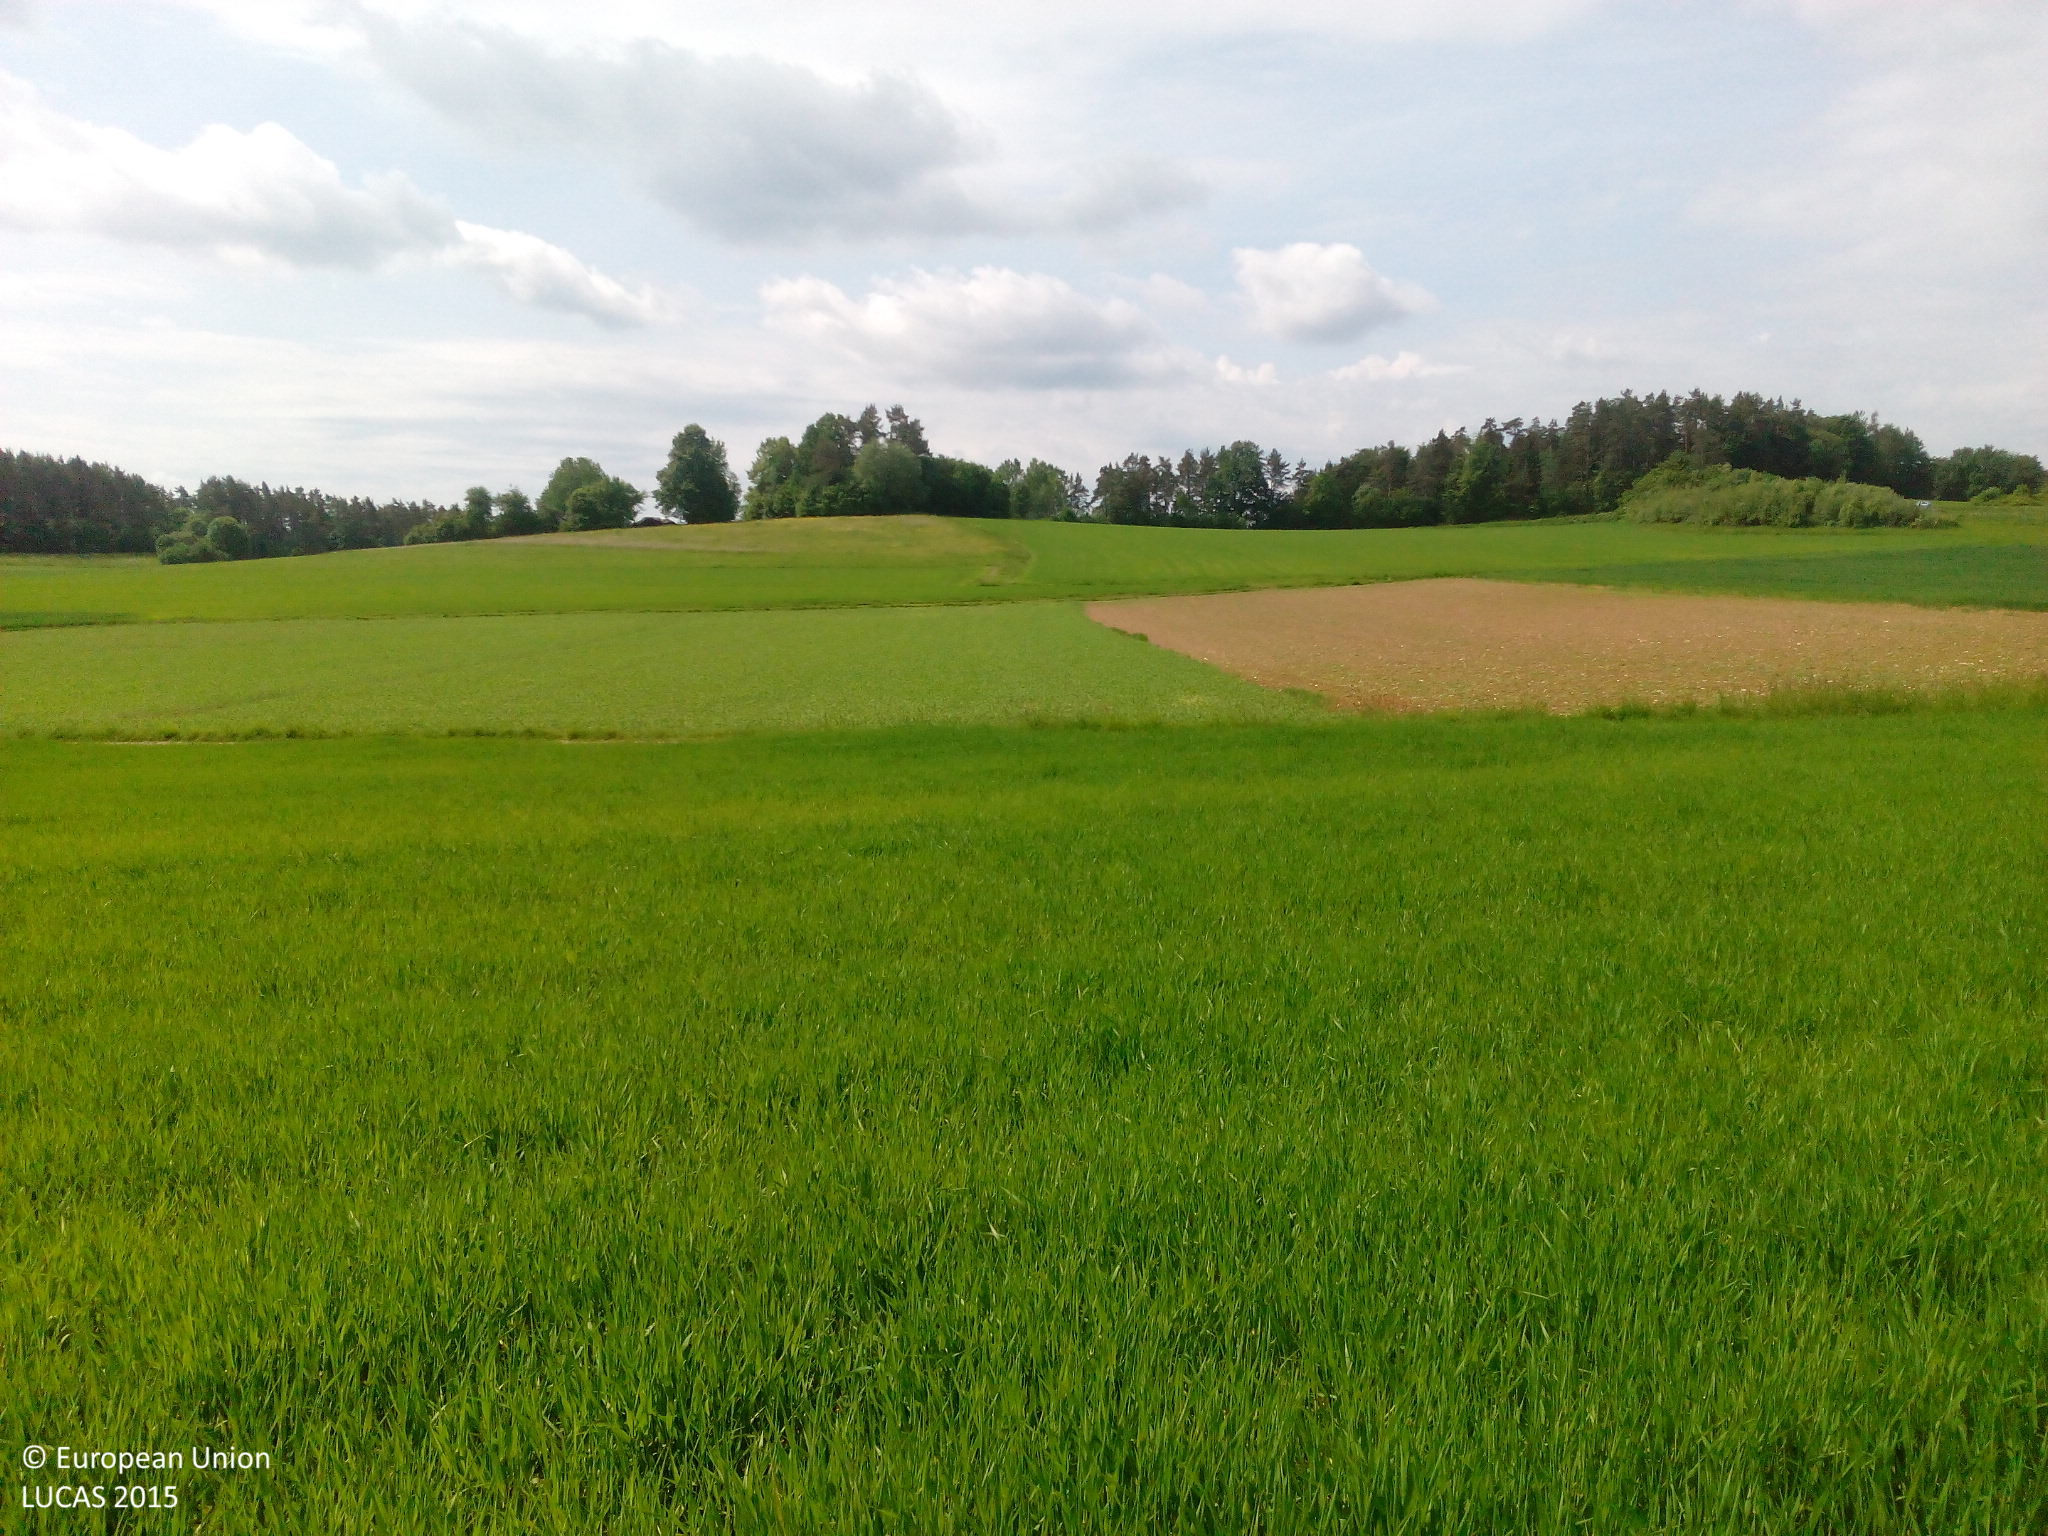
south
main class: Cropland
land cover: Barley
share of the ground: > 75 %
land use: Agriculture (excluding fallow land and kitchen gardens)
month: May
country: DE
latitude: 49.7785
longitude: 11.5133
